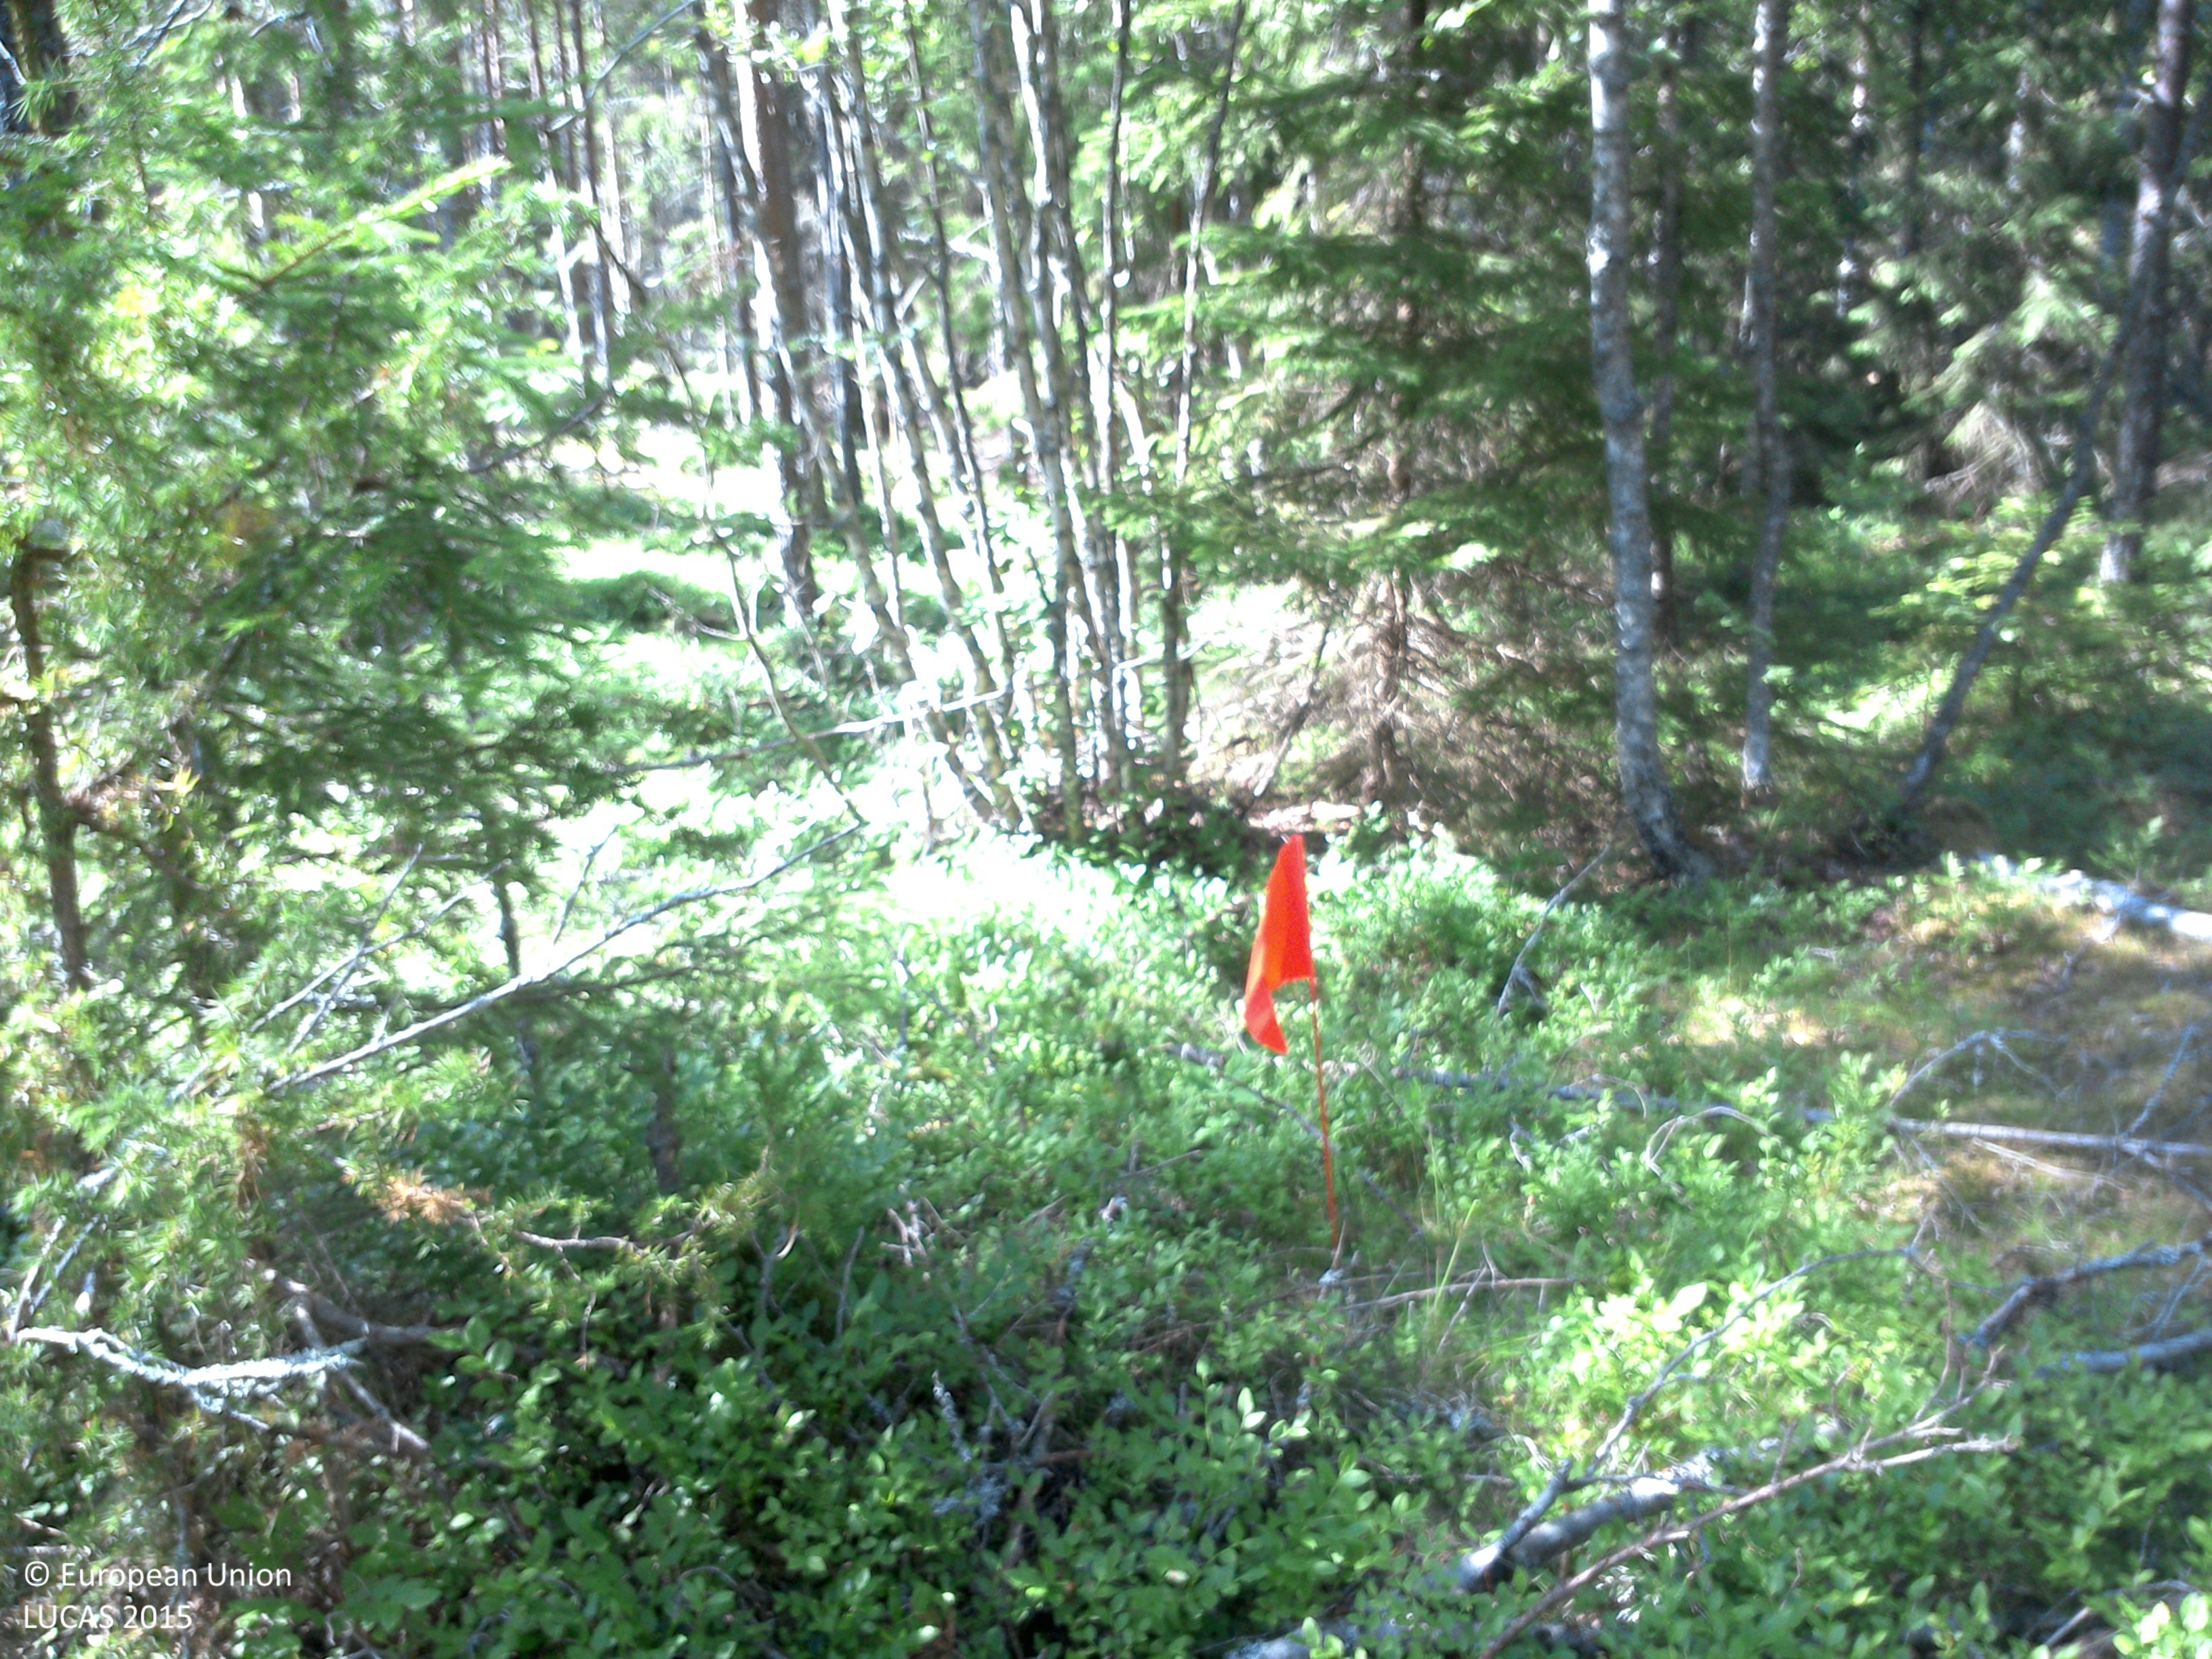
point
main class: Woodland
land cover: Pine dominated coniferous woodland
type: boreal forest
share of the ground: 50 - 75 %
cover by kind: coniferous forest trees 65 %, lichens and mosses 20 %, herbaceous plants 10 %, broadleaved forest trees 5 %
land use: Forestry
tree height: > 5 m
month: June
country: SE
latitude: 58.2499
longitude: 15.5323
